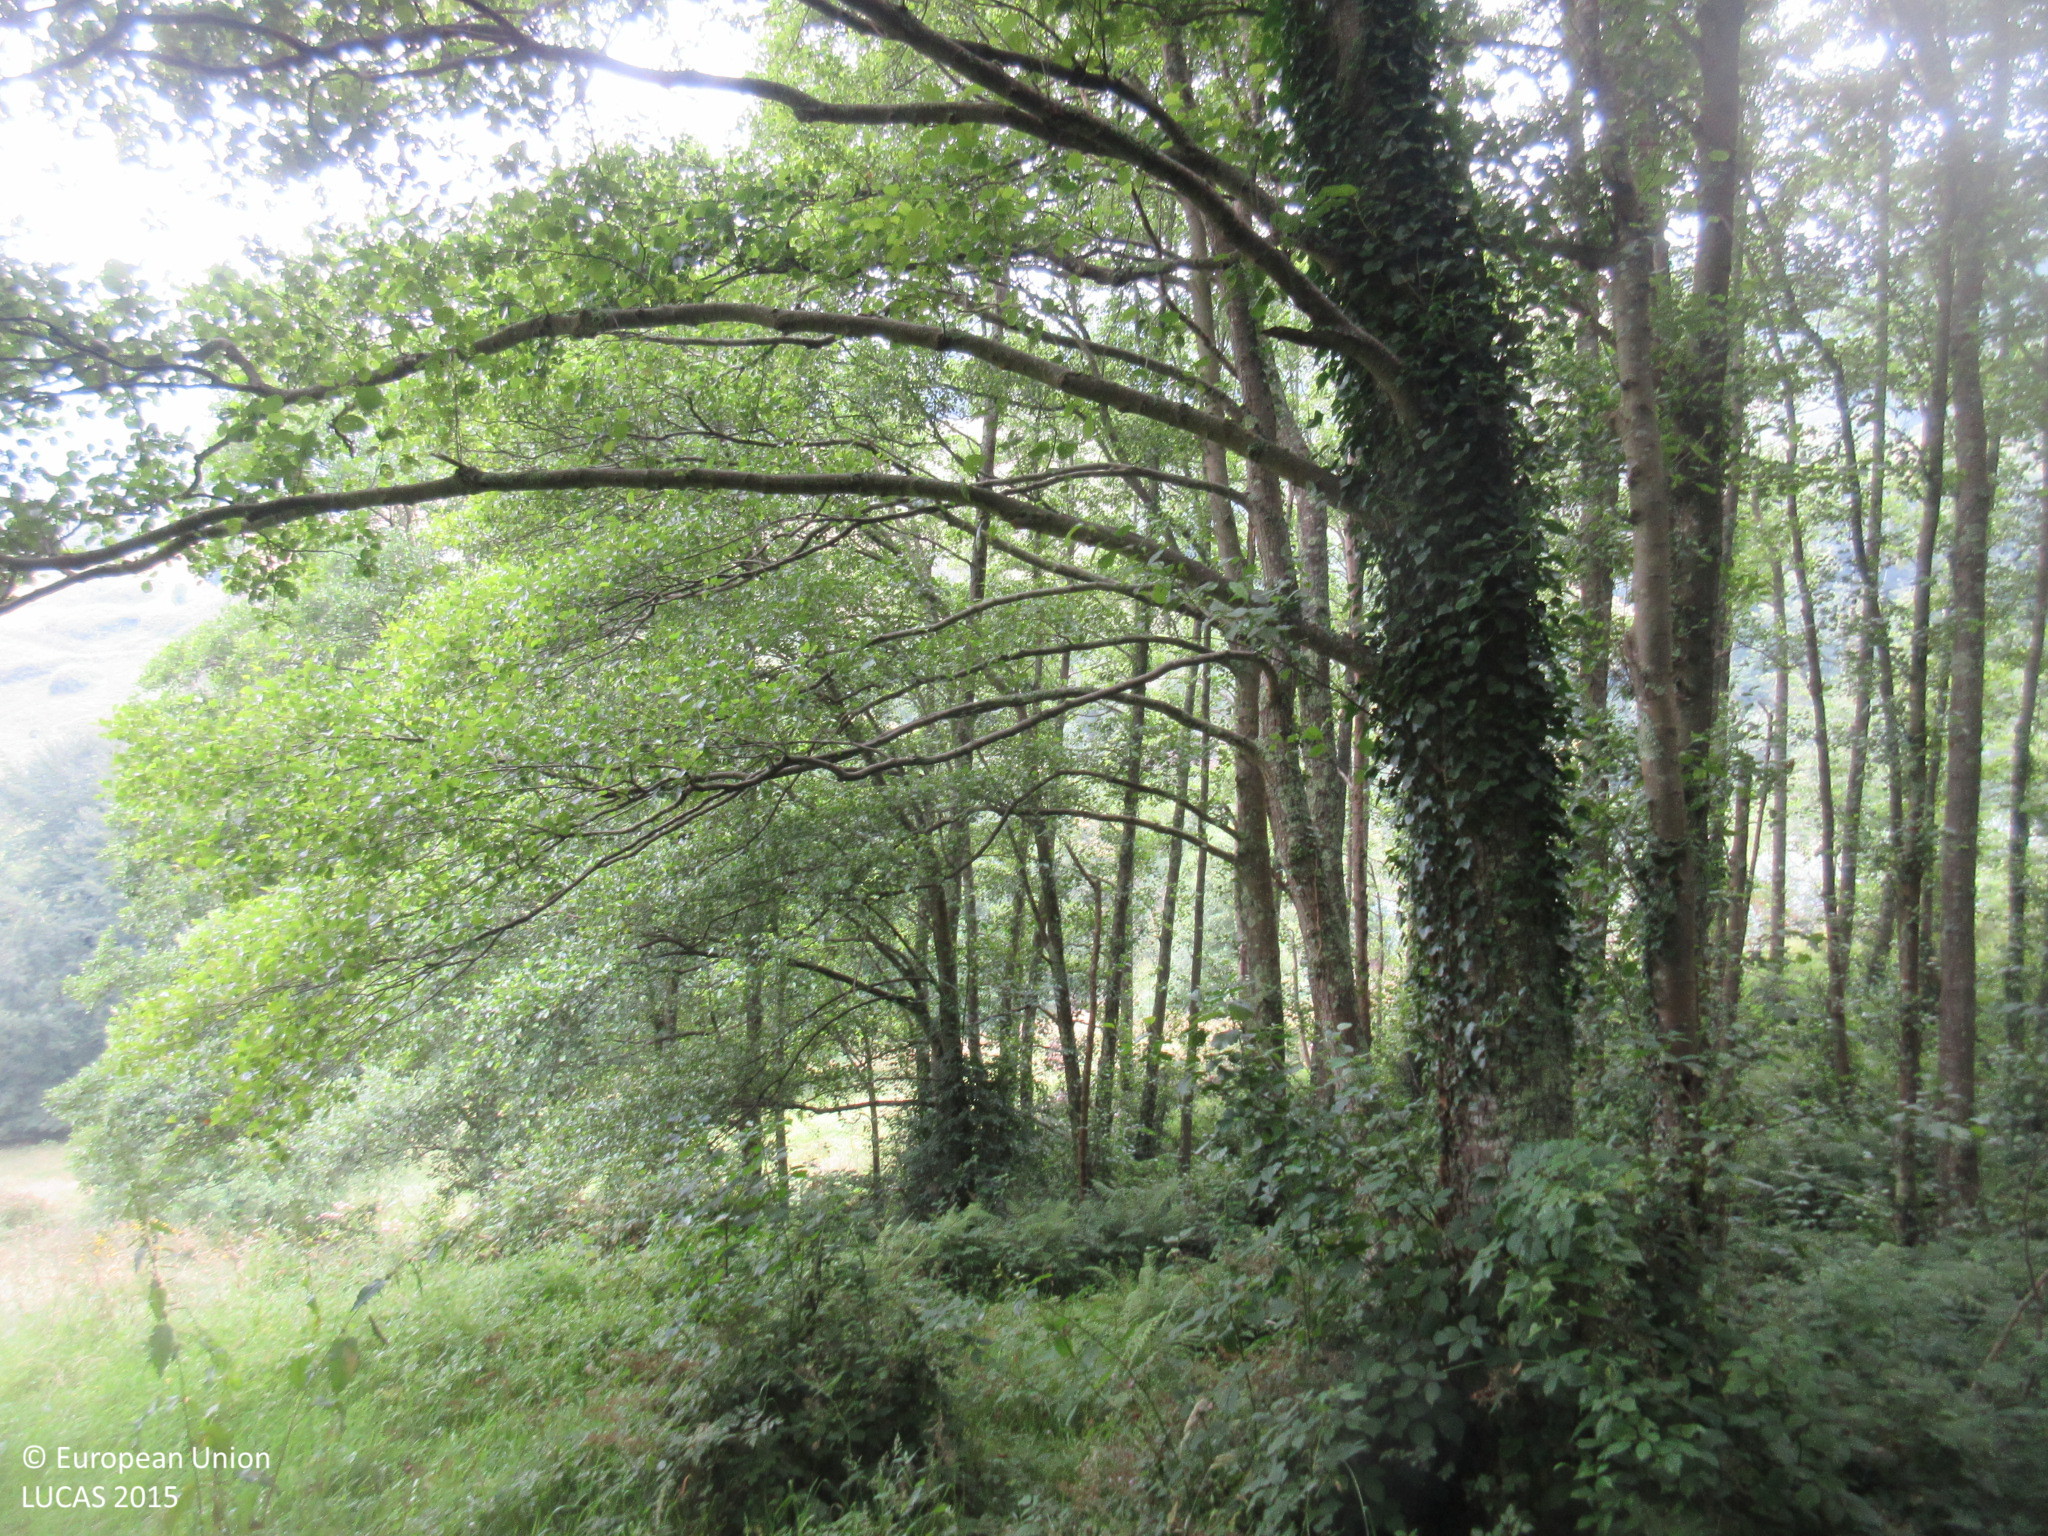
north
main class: Grassland
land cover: Grassland without tree/shrub cover
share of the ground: > 75 %
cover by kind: herbaceous plants 100 %
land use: Agriculture (excluding fallow land and kitchen gardens)
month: July
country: ES
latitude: 43.4338
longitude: -6.3203
